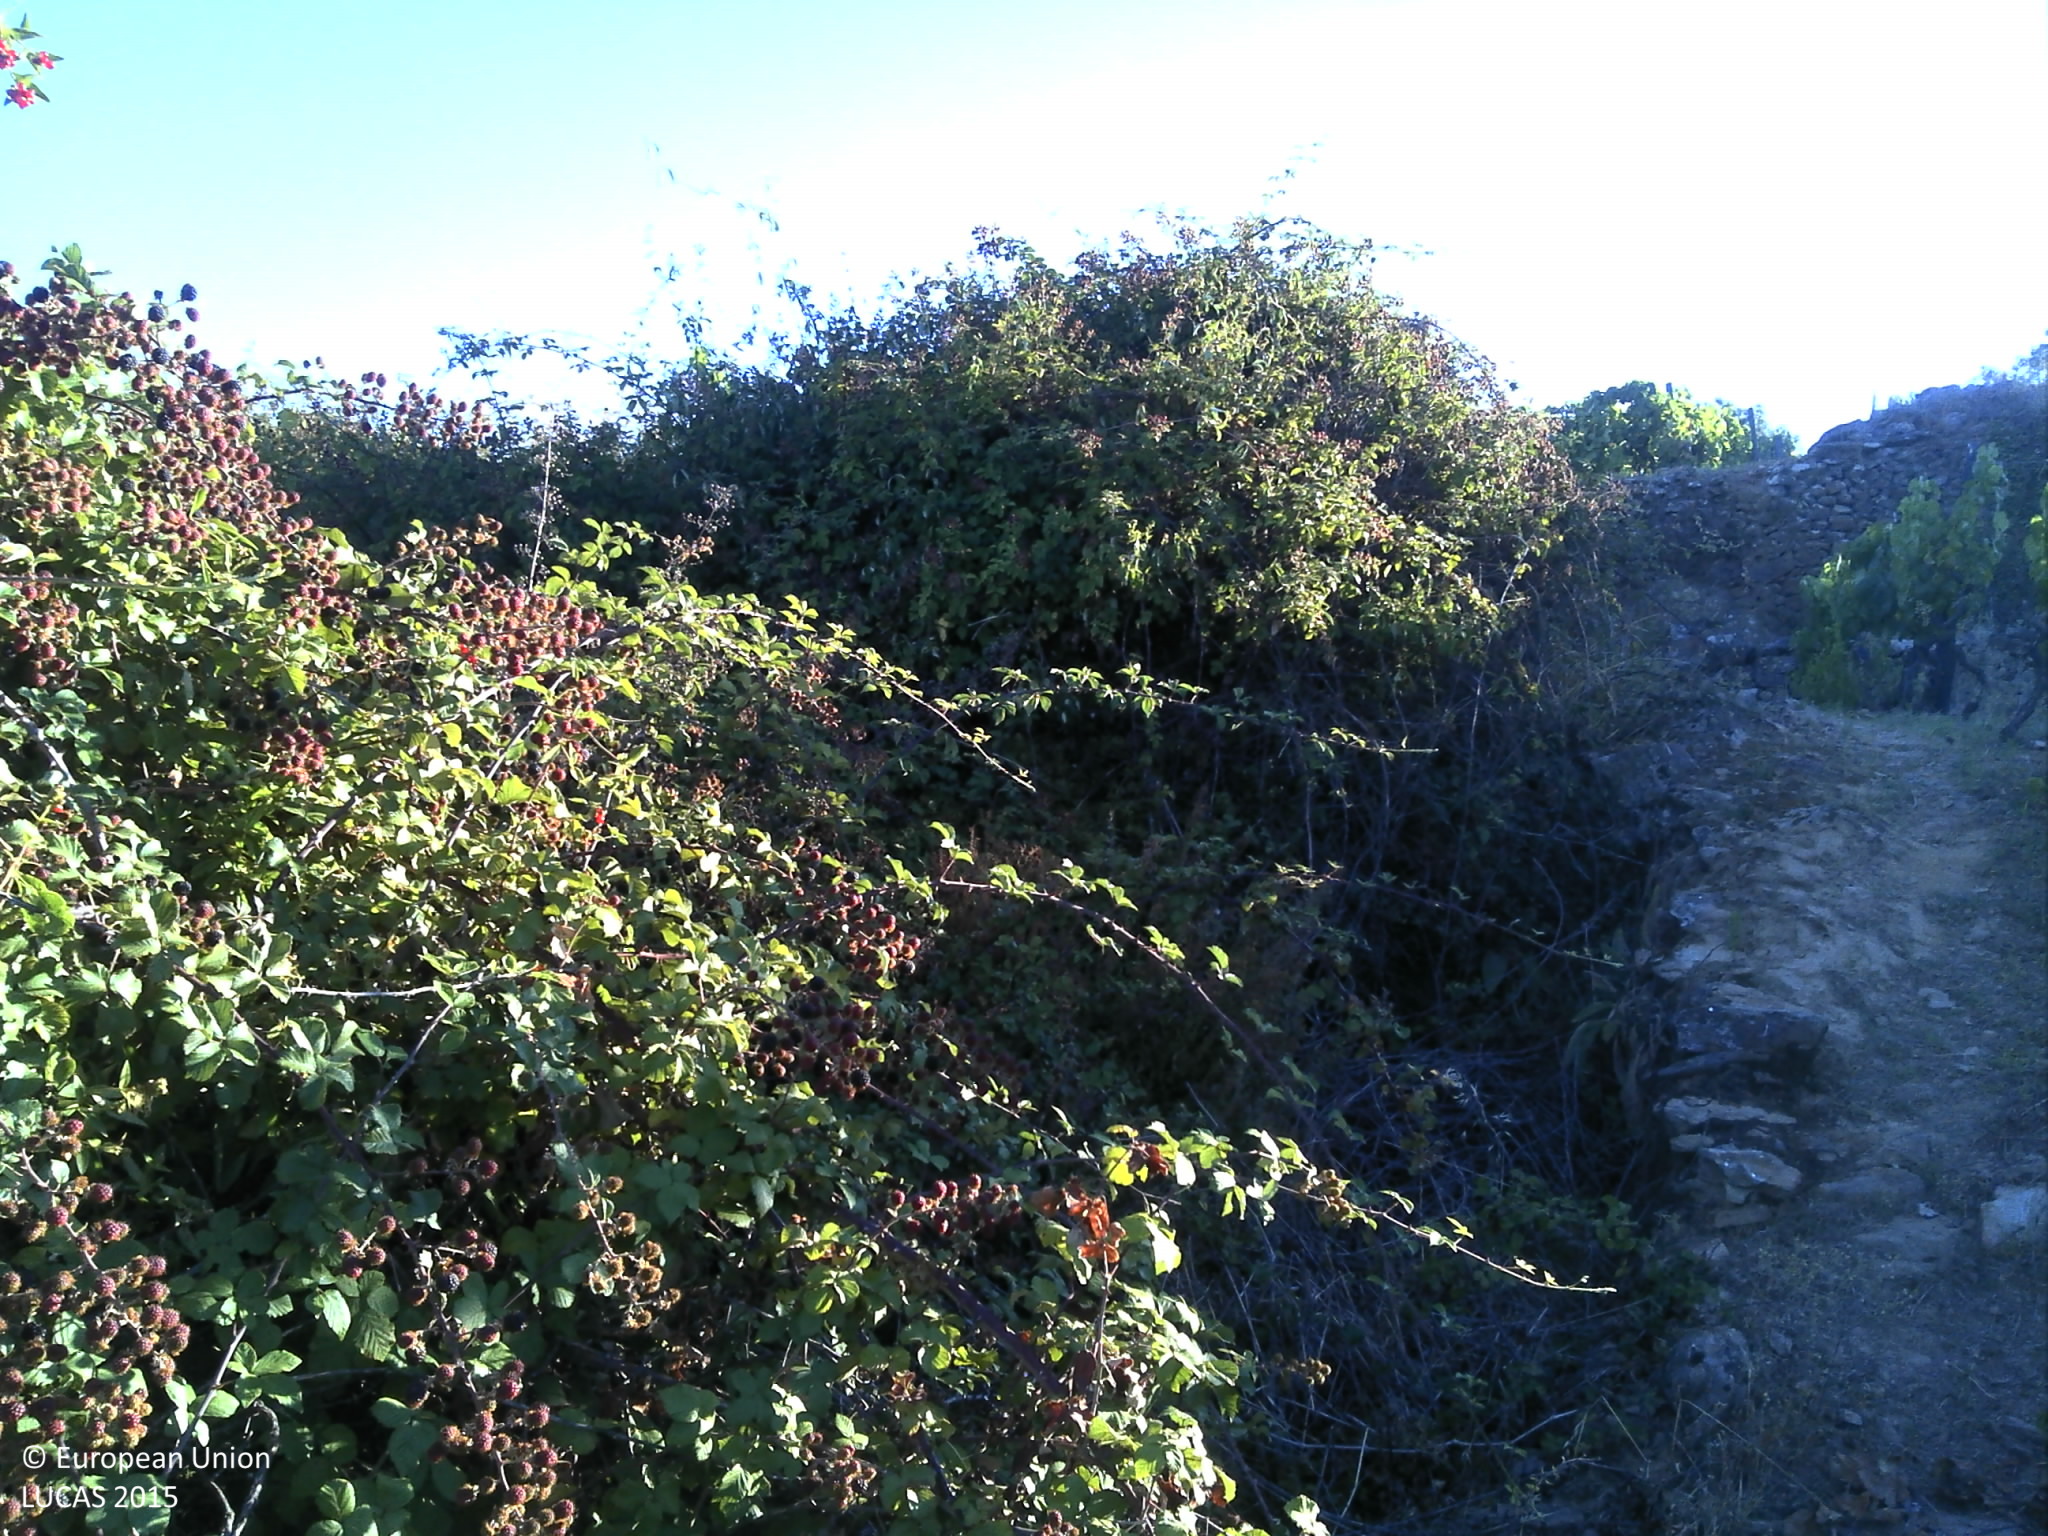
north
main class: Shrubland
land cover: Shrubland without tree cover
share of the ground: > 75 %
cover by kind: shrubs 100 %
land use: Abandoned areas
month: July
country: PT
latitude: 41.2965
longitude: -7.5244
